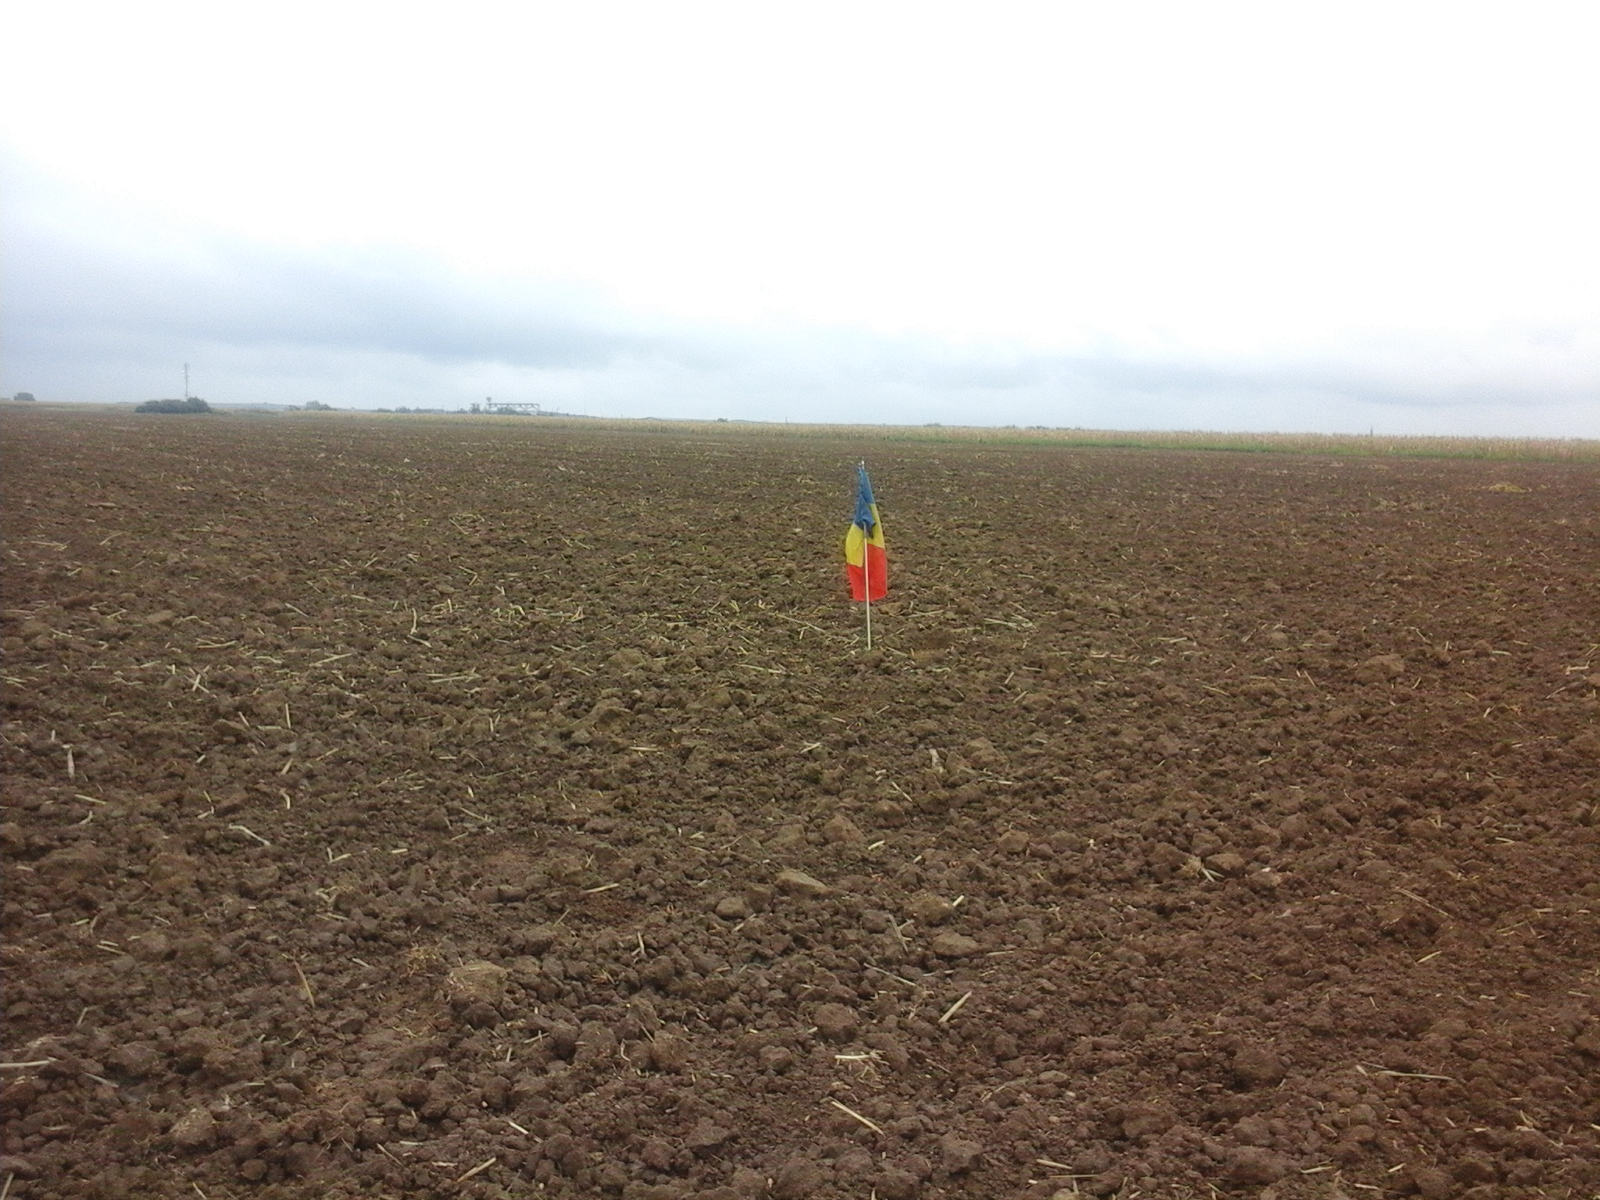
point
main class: Cropland
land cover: Common wheat
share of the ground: < 10 %
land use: Agriculture (excluding fallow land and kitchen gardens)
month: September
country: RO
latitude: 47.1753
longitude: 21.9083
